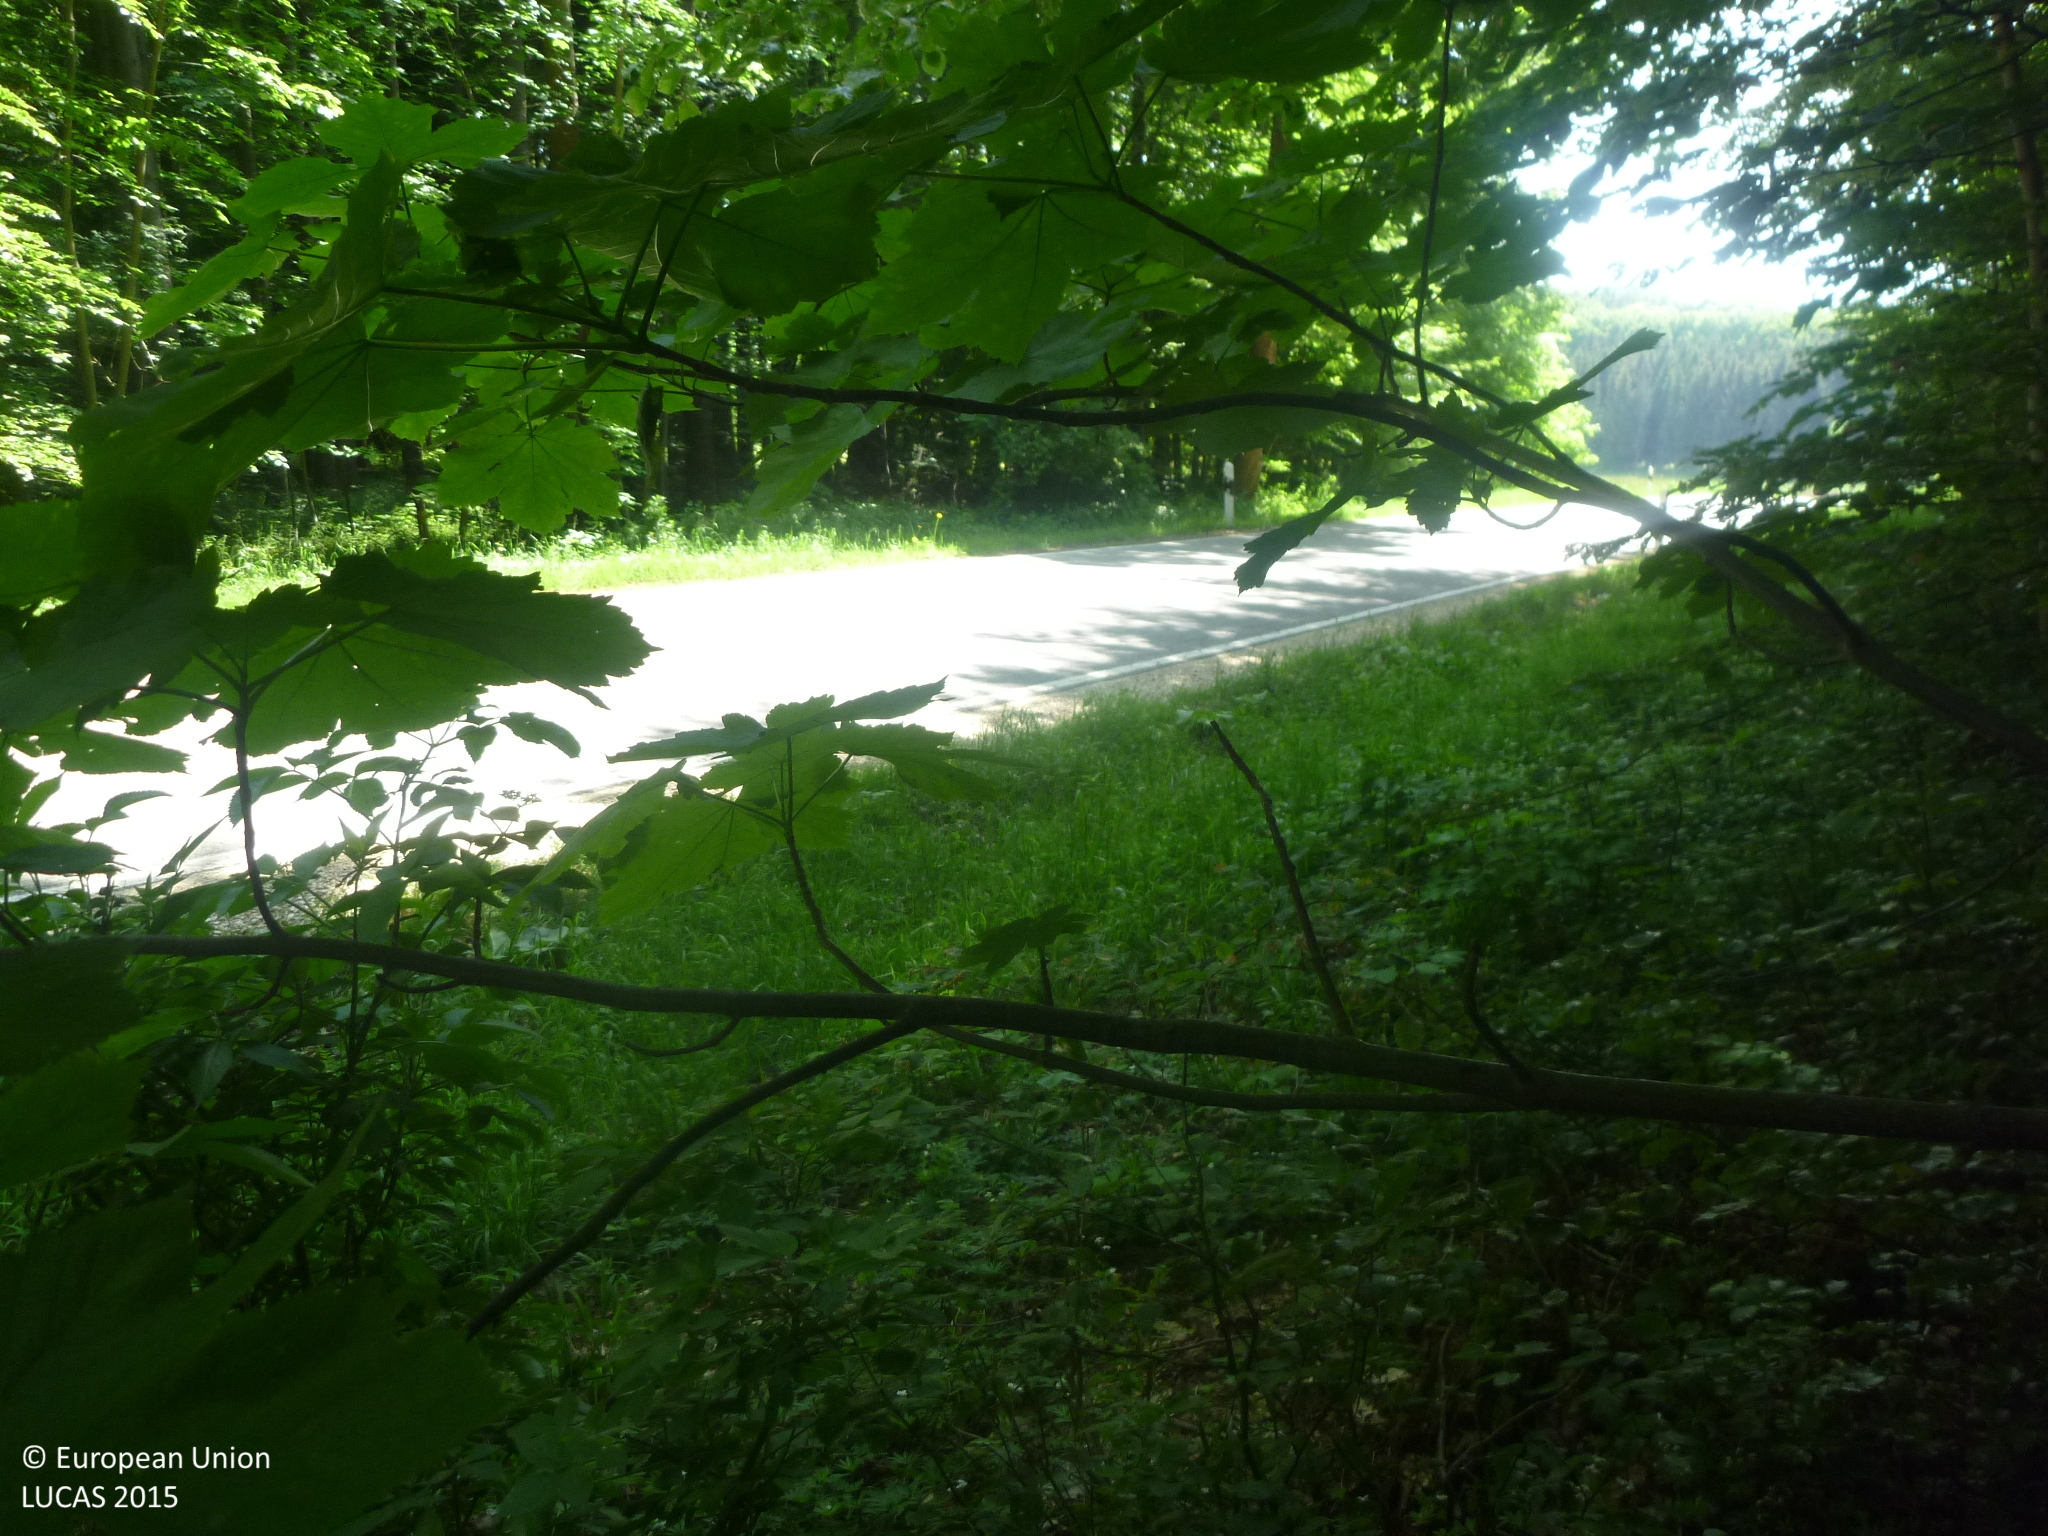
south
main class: Woodland
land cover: Broadleaved woodland
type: mesophytic deciduous forest
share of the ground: > 75 %
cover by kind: broadleaved forest trees 100 %
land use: Forestry
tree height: > 5 m
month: May
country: DE
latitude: 48.4736
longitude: 9.3646
